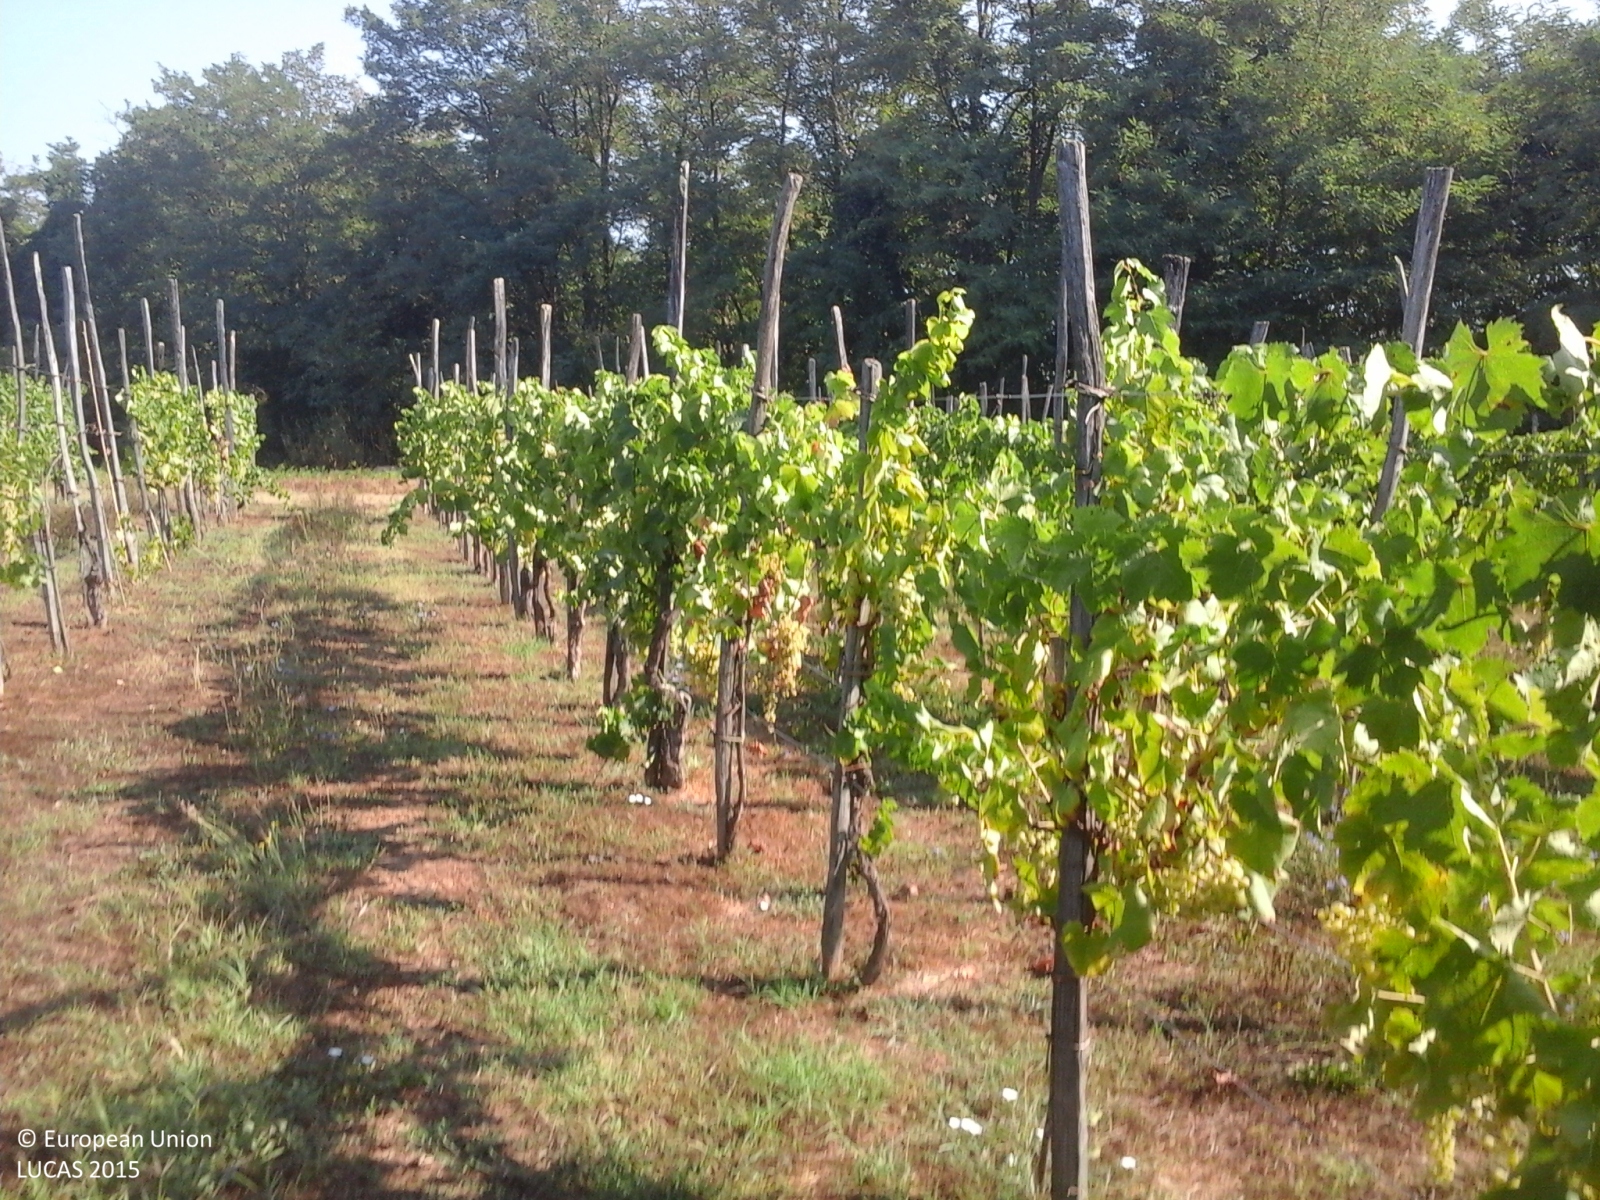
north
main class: Cropland
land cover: Vineyards
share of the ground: > 75 %
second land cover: Grassland without tree/shrub cover
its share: > 75 %
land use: Agriculture (excluding fallow land and kitchen gardens)
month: August
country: IT
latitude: 43.8435
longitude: 10.6327
